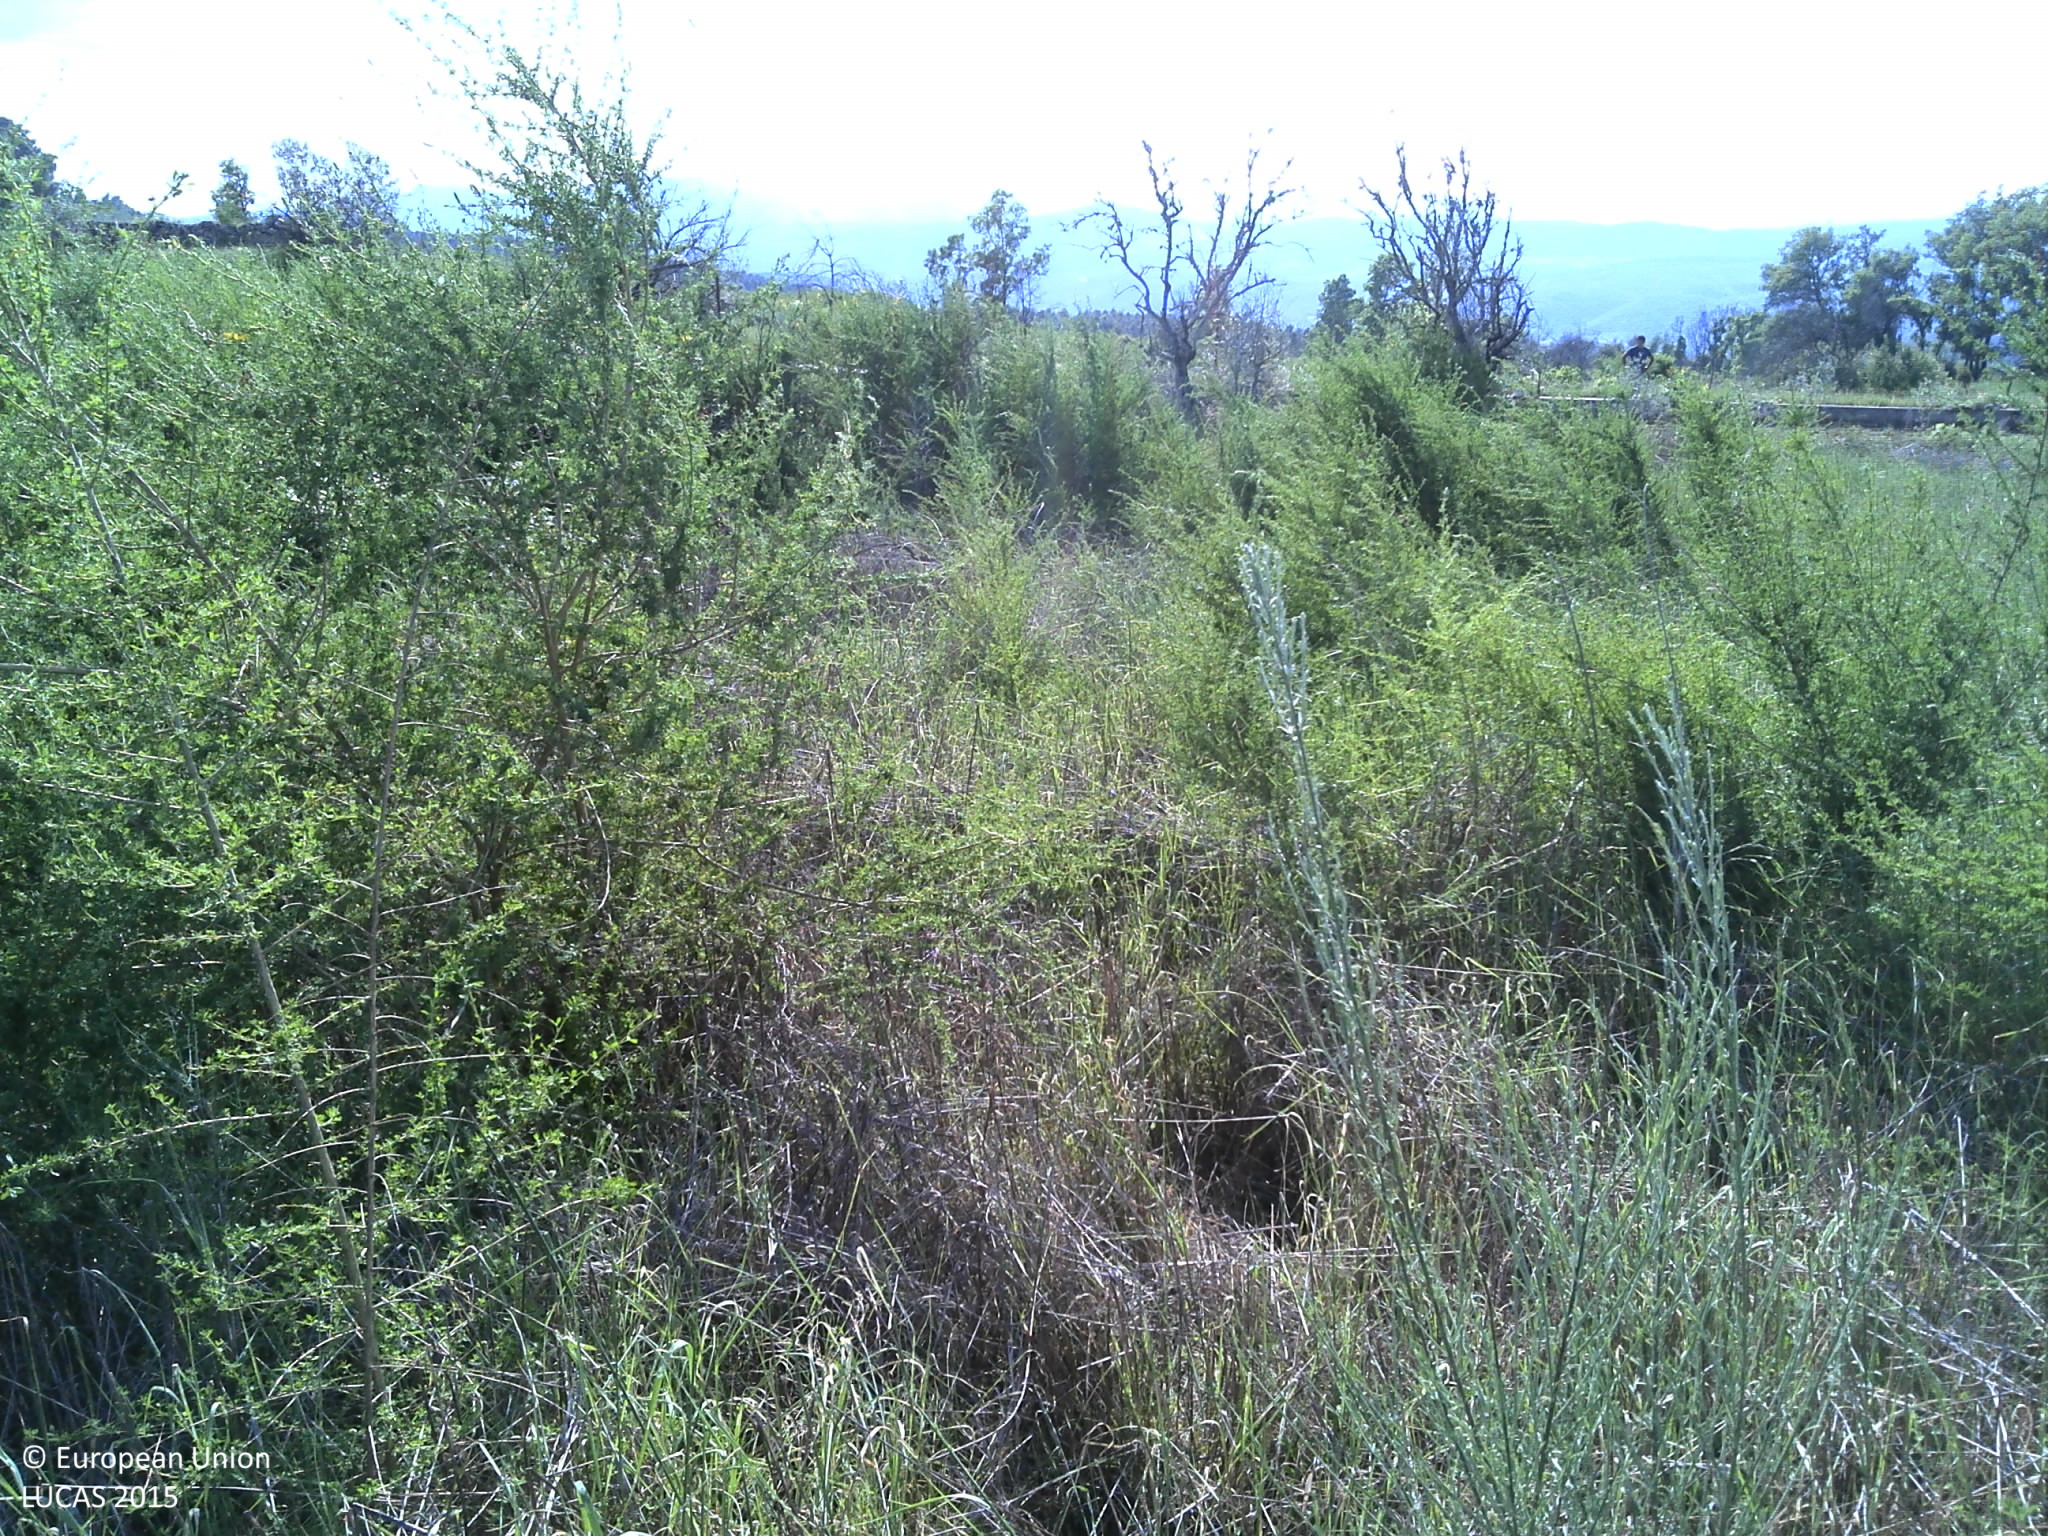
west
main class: Shrubland
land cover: Shrubland without tree cover
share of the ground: > 75 %
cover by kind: shrubs 60 %, herbaceous plants 40 %
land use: Forestry
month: May
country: PT
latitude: 41.6637
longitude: -7.5328
